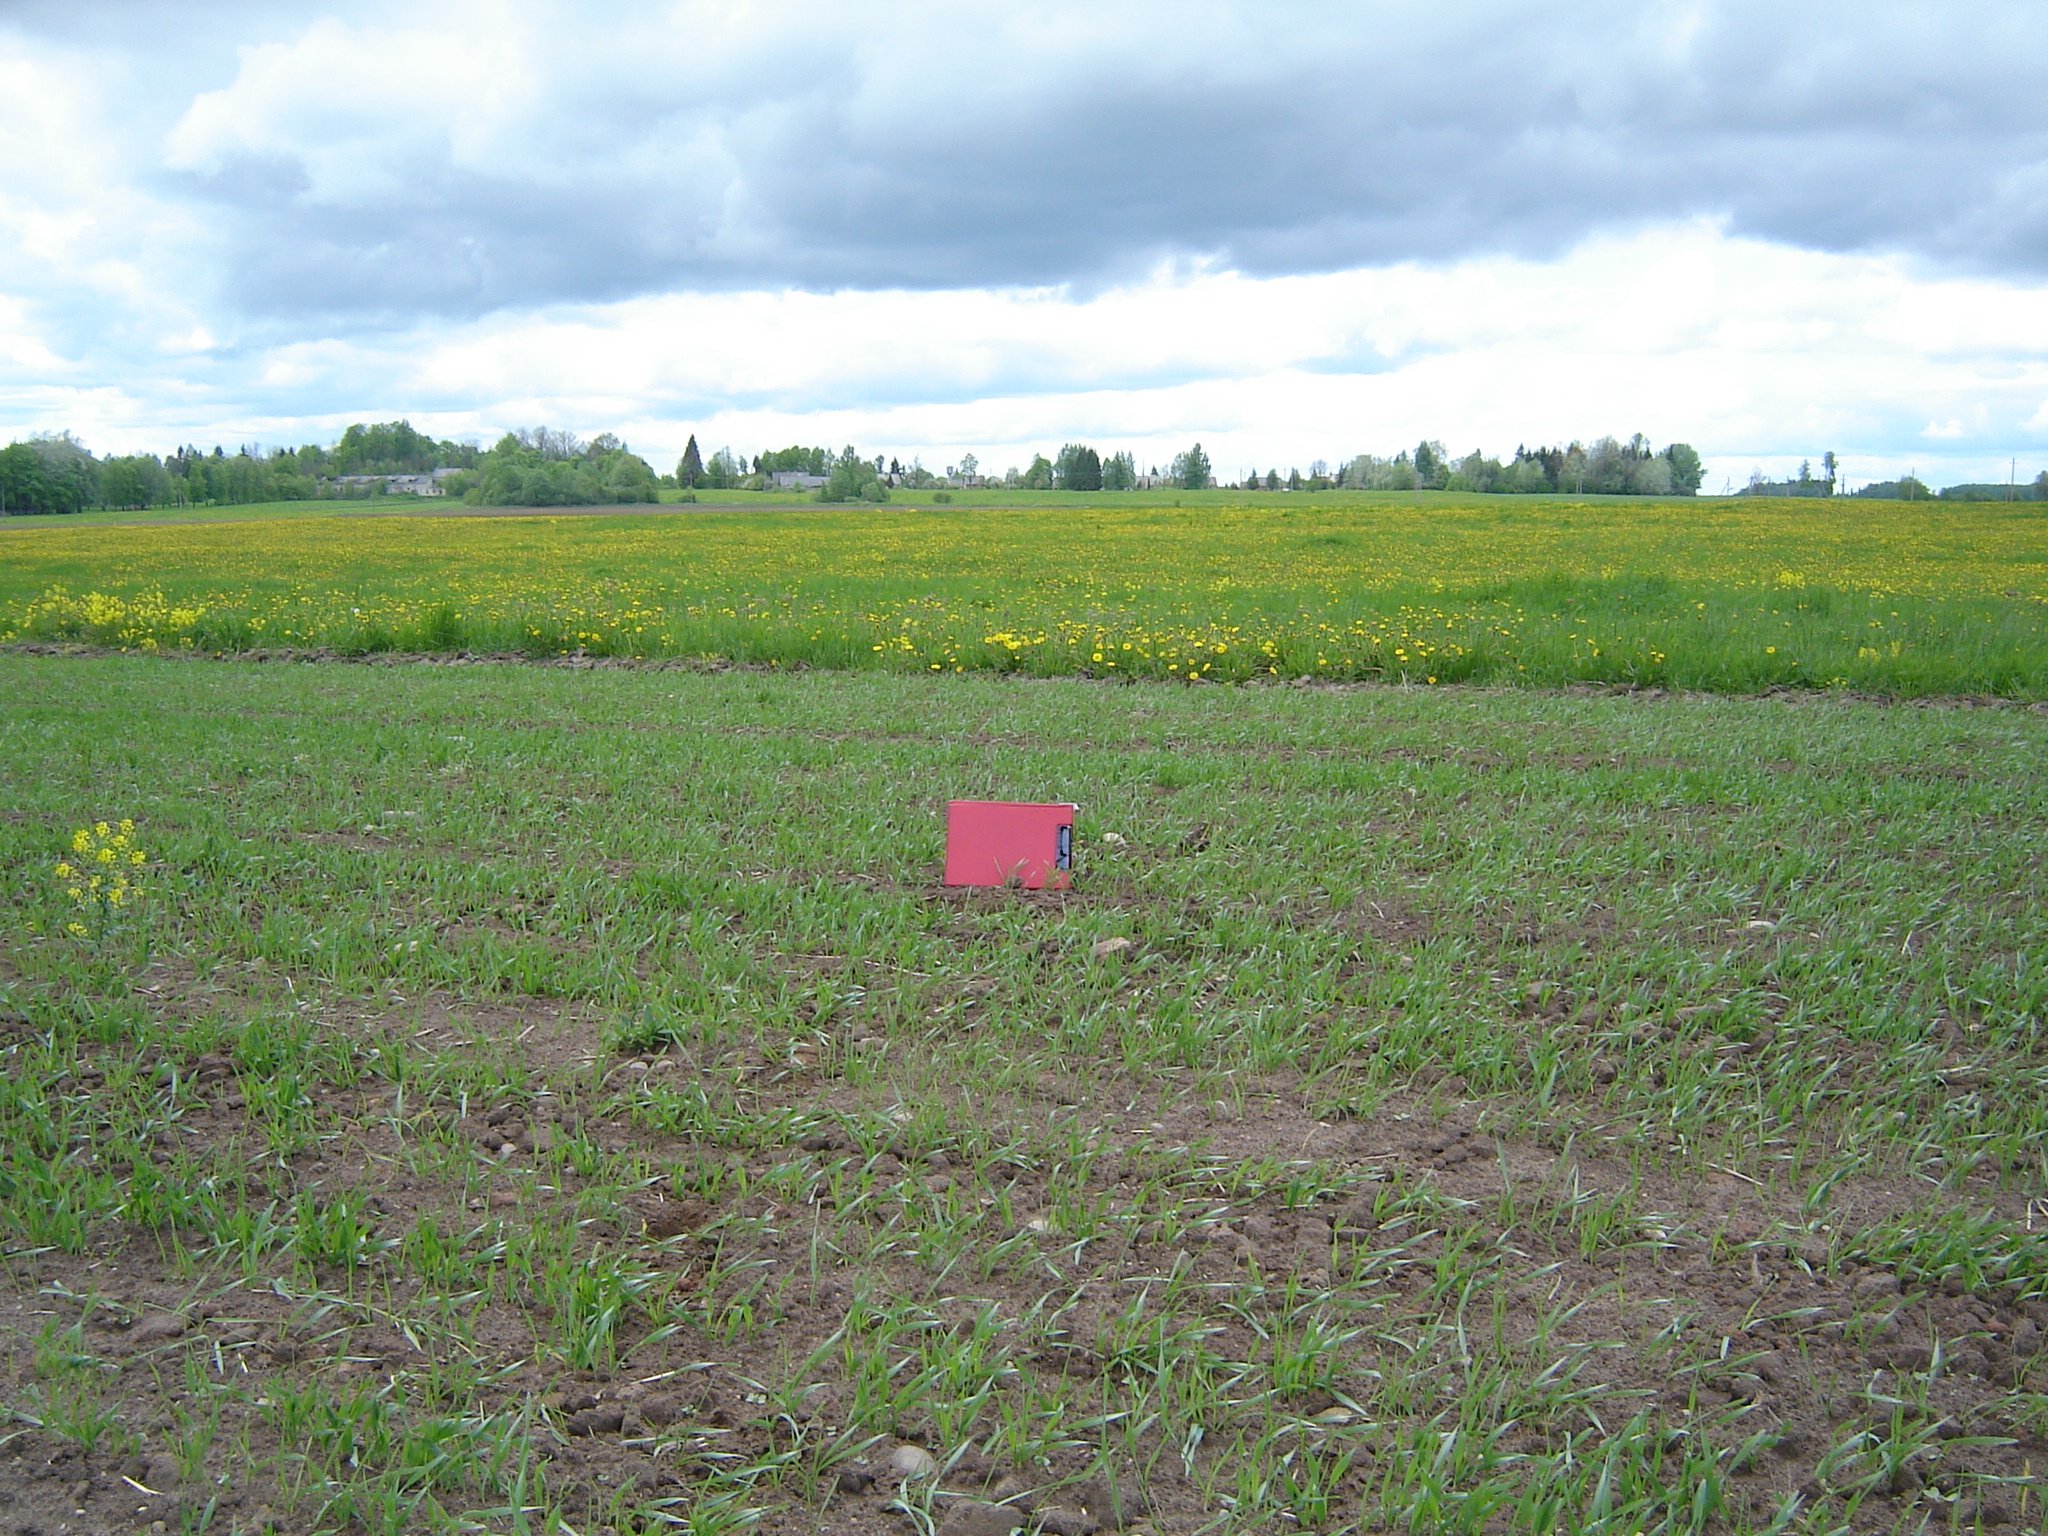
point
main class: Cropland
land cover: Barley
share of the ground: 25 - 50 %
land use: Agriculture (excluding fallow land and kitchen gardens)
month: May
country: LT
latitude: 56.0171
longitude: 25.2761
